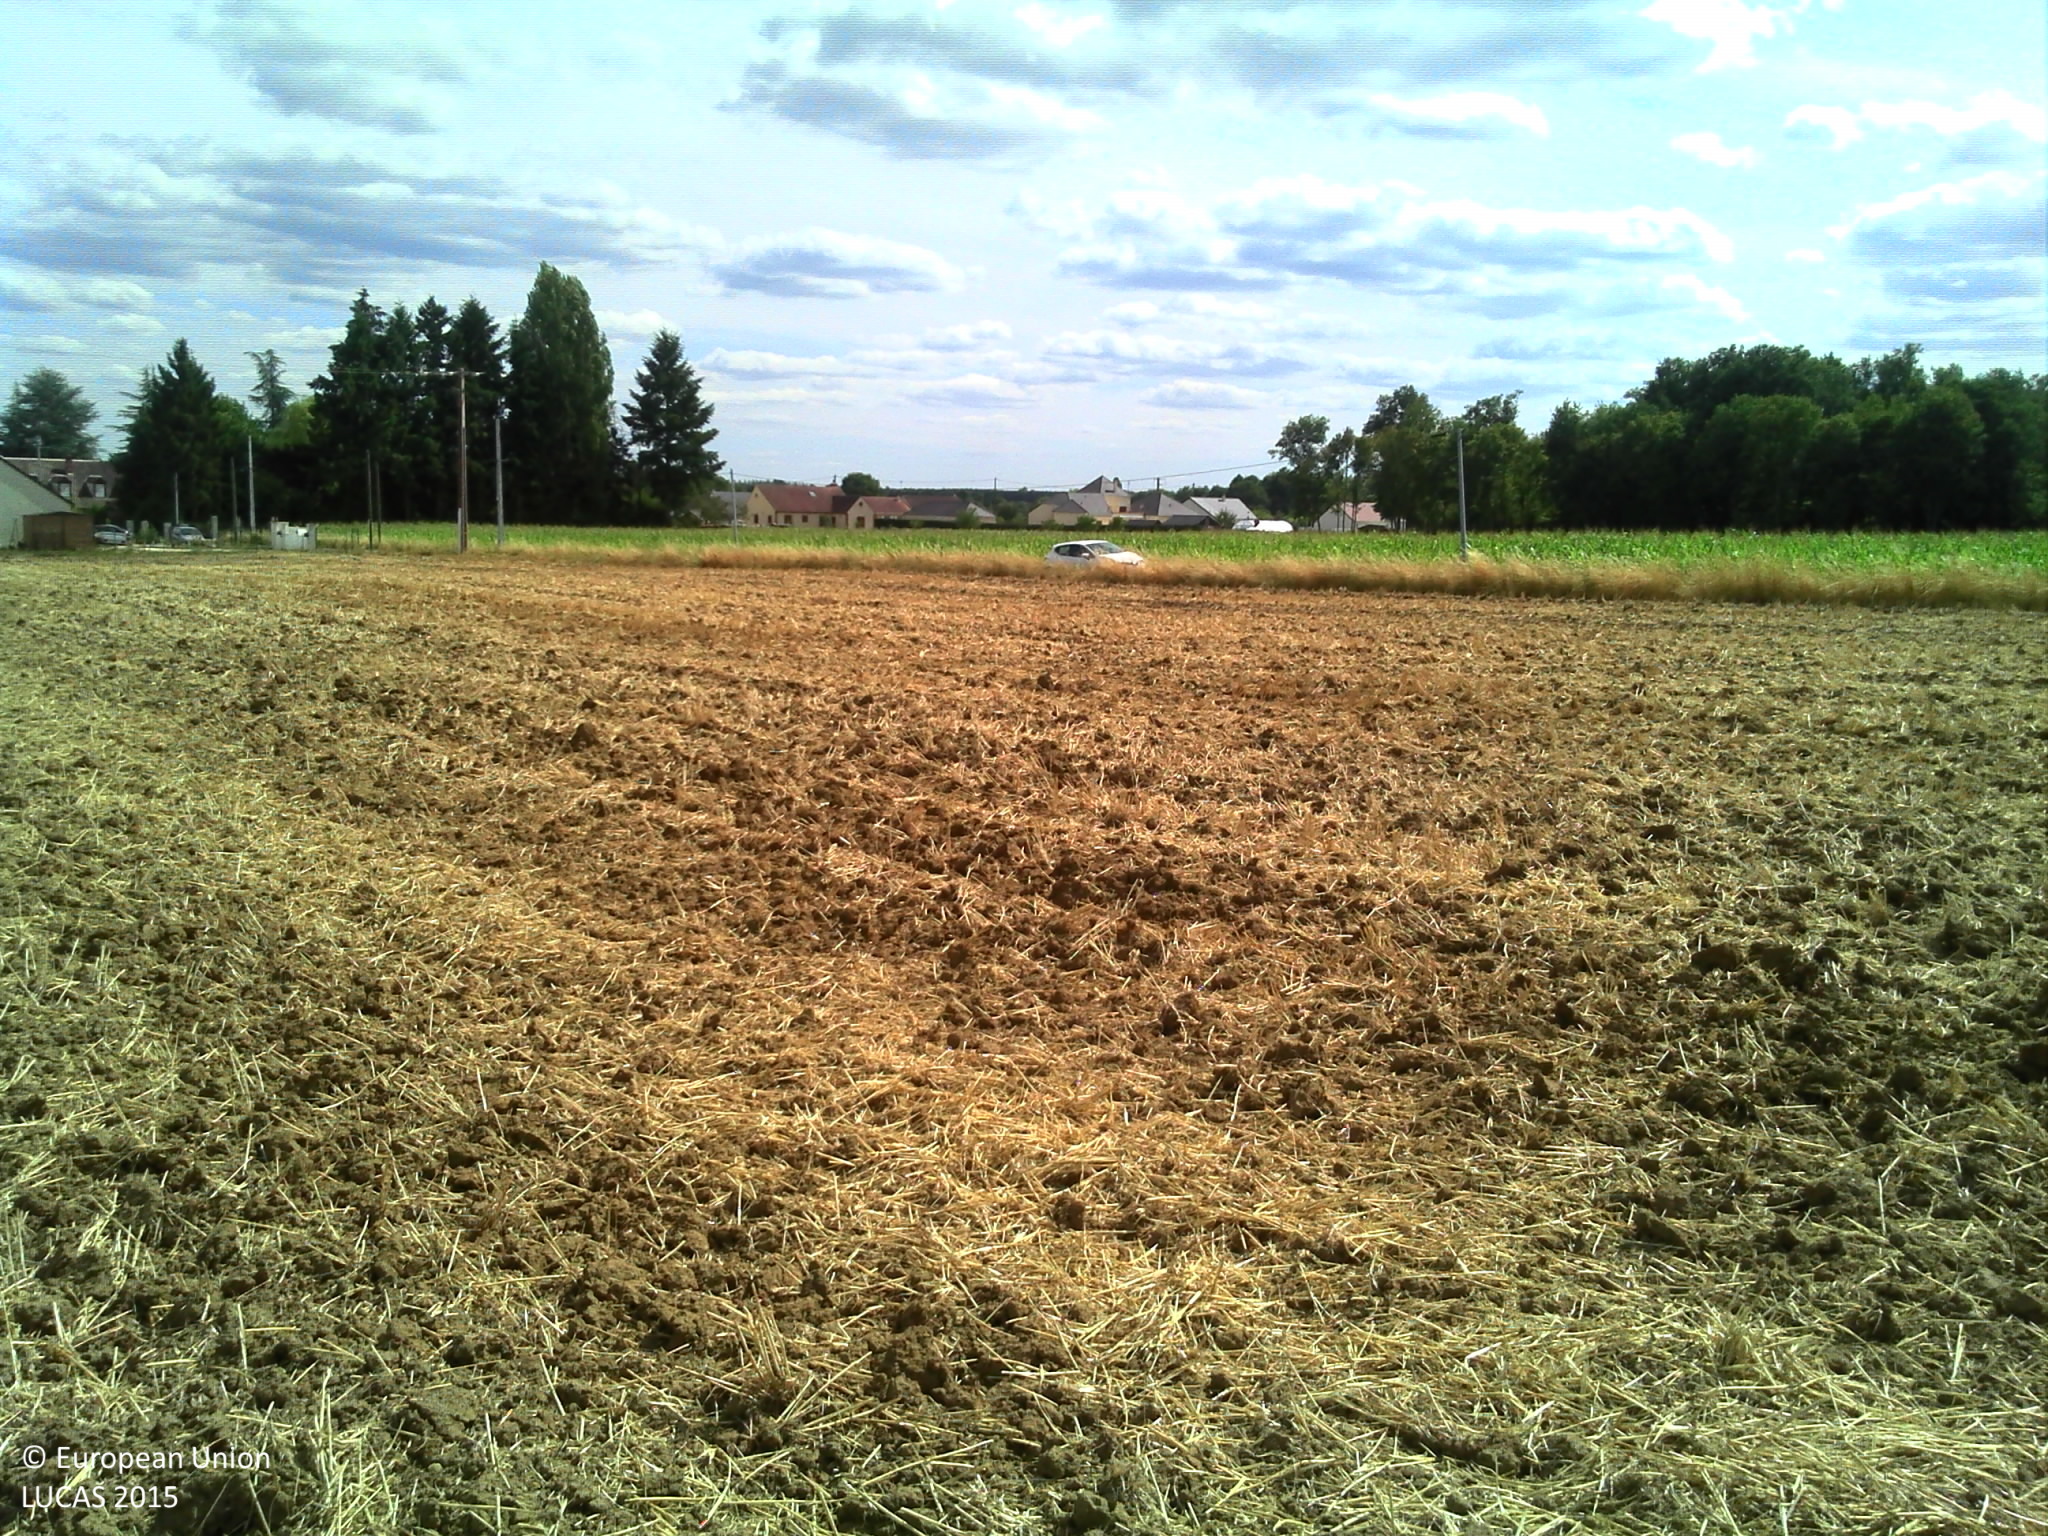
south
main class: Cropland
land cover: Common wheat
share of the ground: > 75 %
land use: Agriculture (excluding fallow land and kitchen gardens)
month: July
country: FR
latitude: 47.9199
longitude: 2.5910
